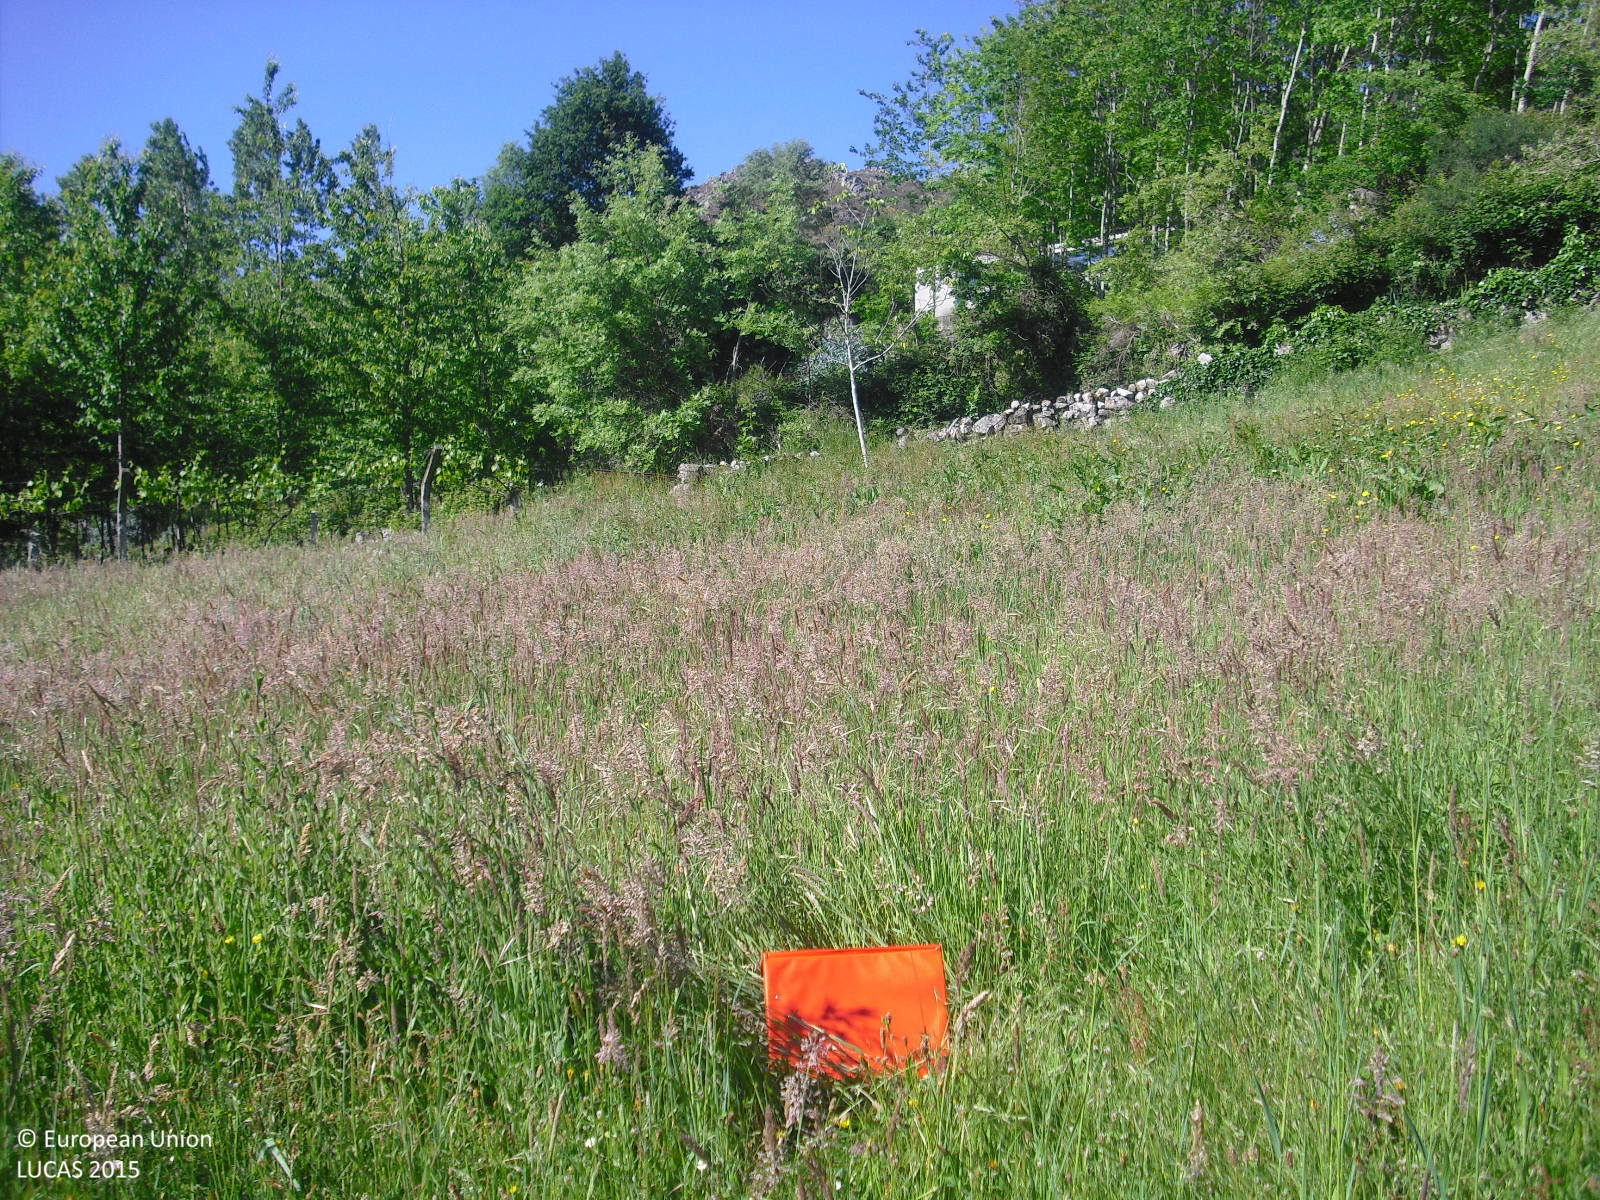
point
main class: Grassland
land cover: Grassland without tree/shrub cover
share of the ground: > 75 %
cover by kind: herbaceous plants 100 %
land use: Agriculture (excluding fallow land and kitchen gardens)
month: May
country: ES
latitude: 41.9596
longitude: -8.1413
